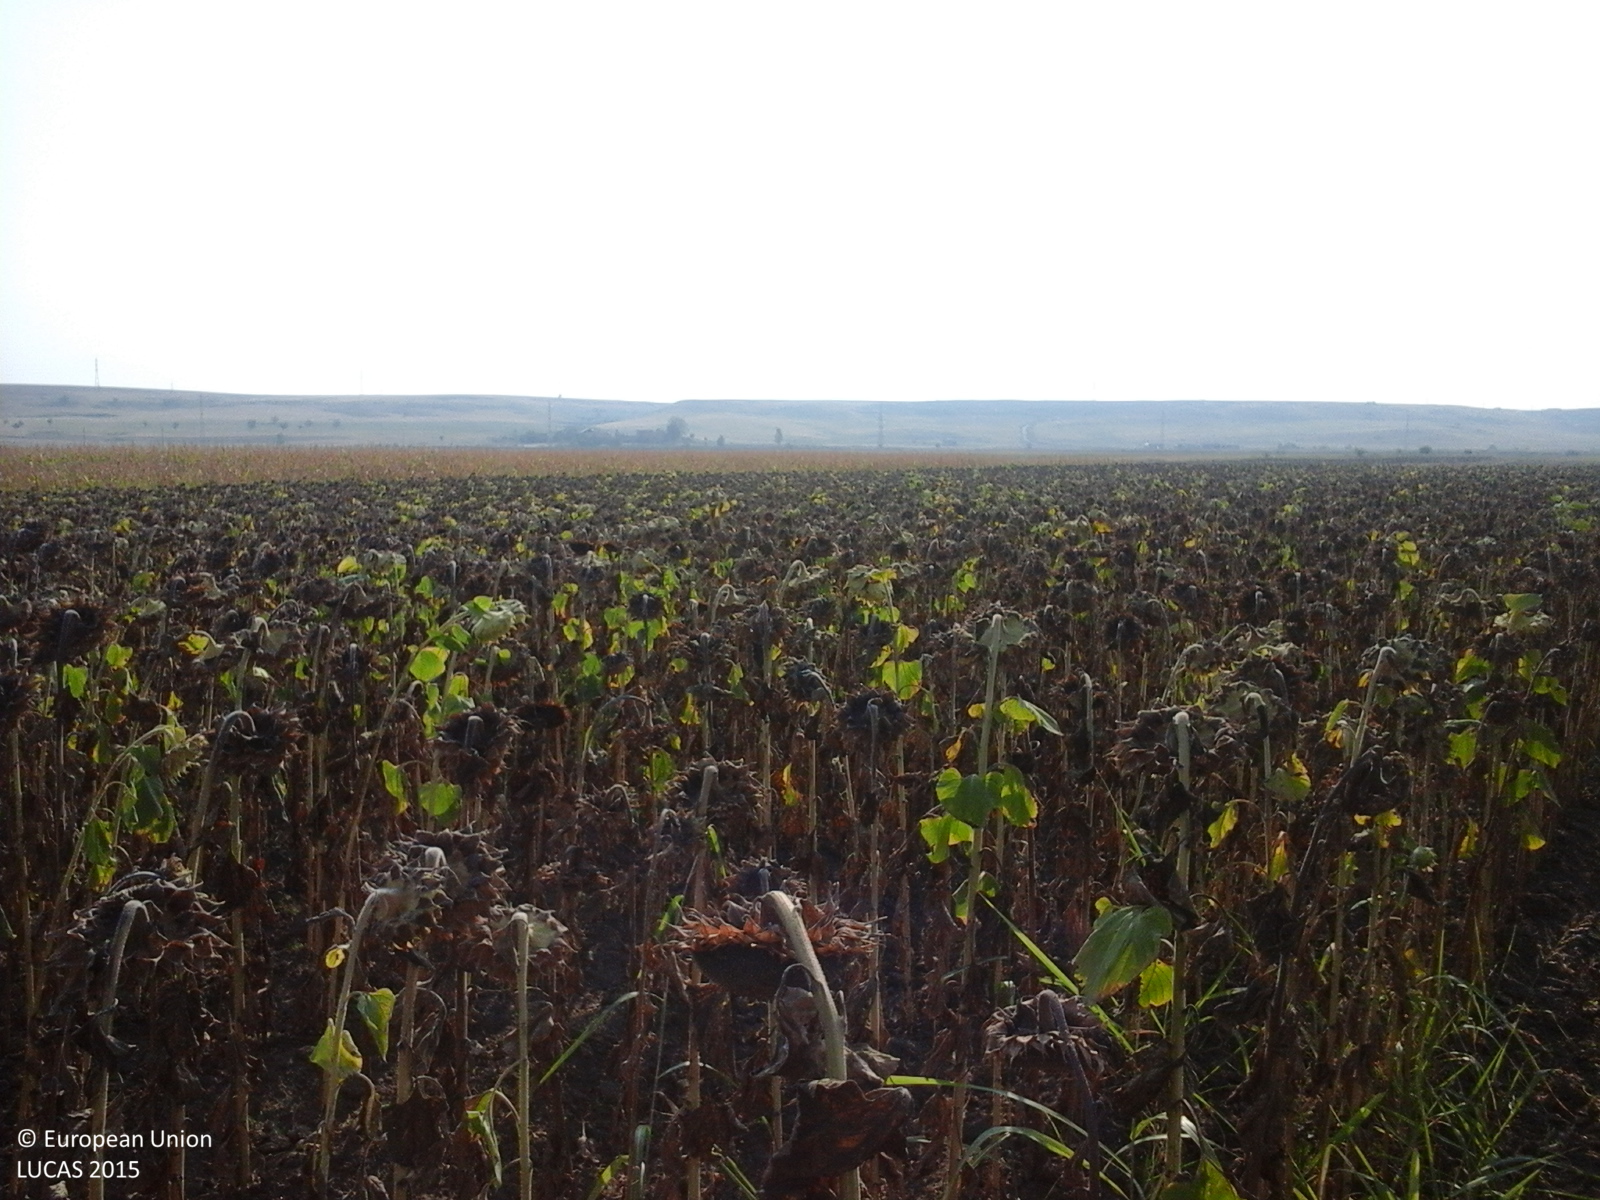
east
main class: Cropland
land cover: Sunflower
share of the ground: > 75 %
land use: Agriculture (excluding fallow land and kitchen gardens)
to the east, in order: Sunflower; Maize; Common wheat; Grass margins; Tracks; Grass margins; Sunflower
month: August
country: RO
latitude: 44.1338
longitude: 22.9787
